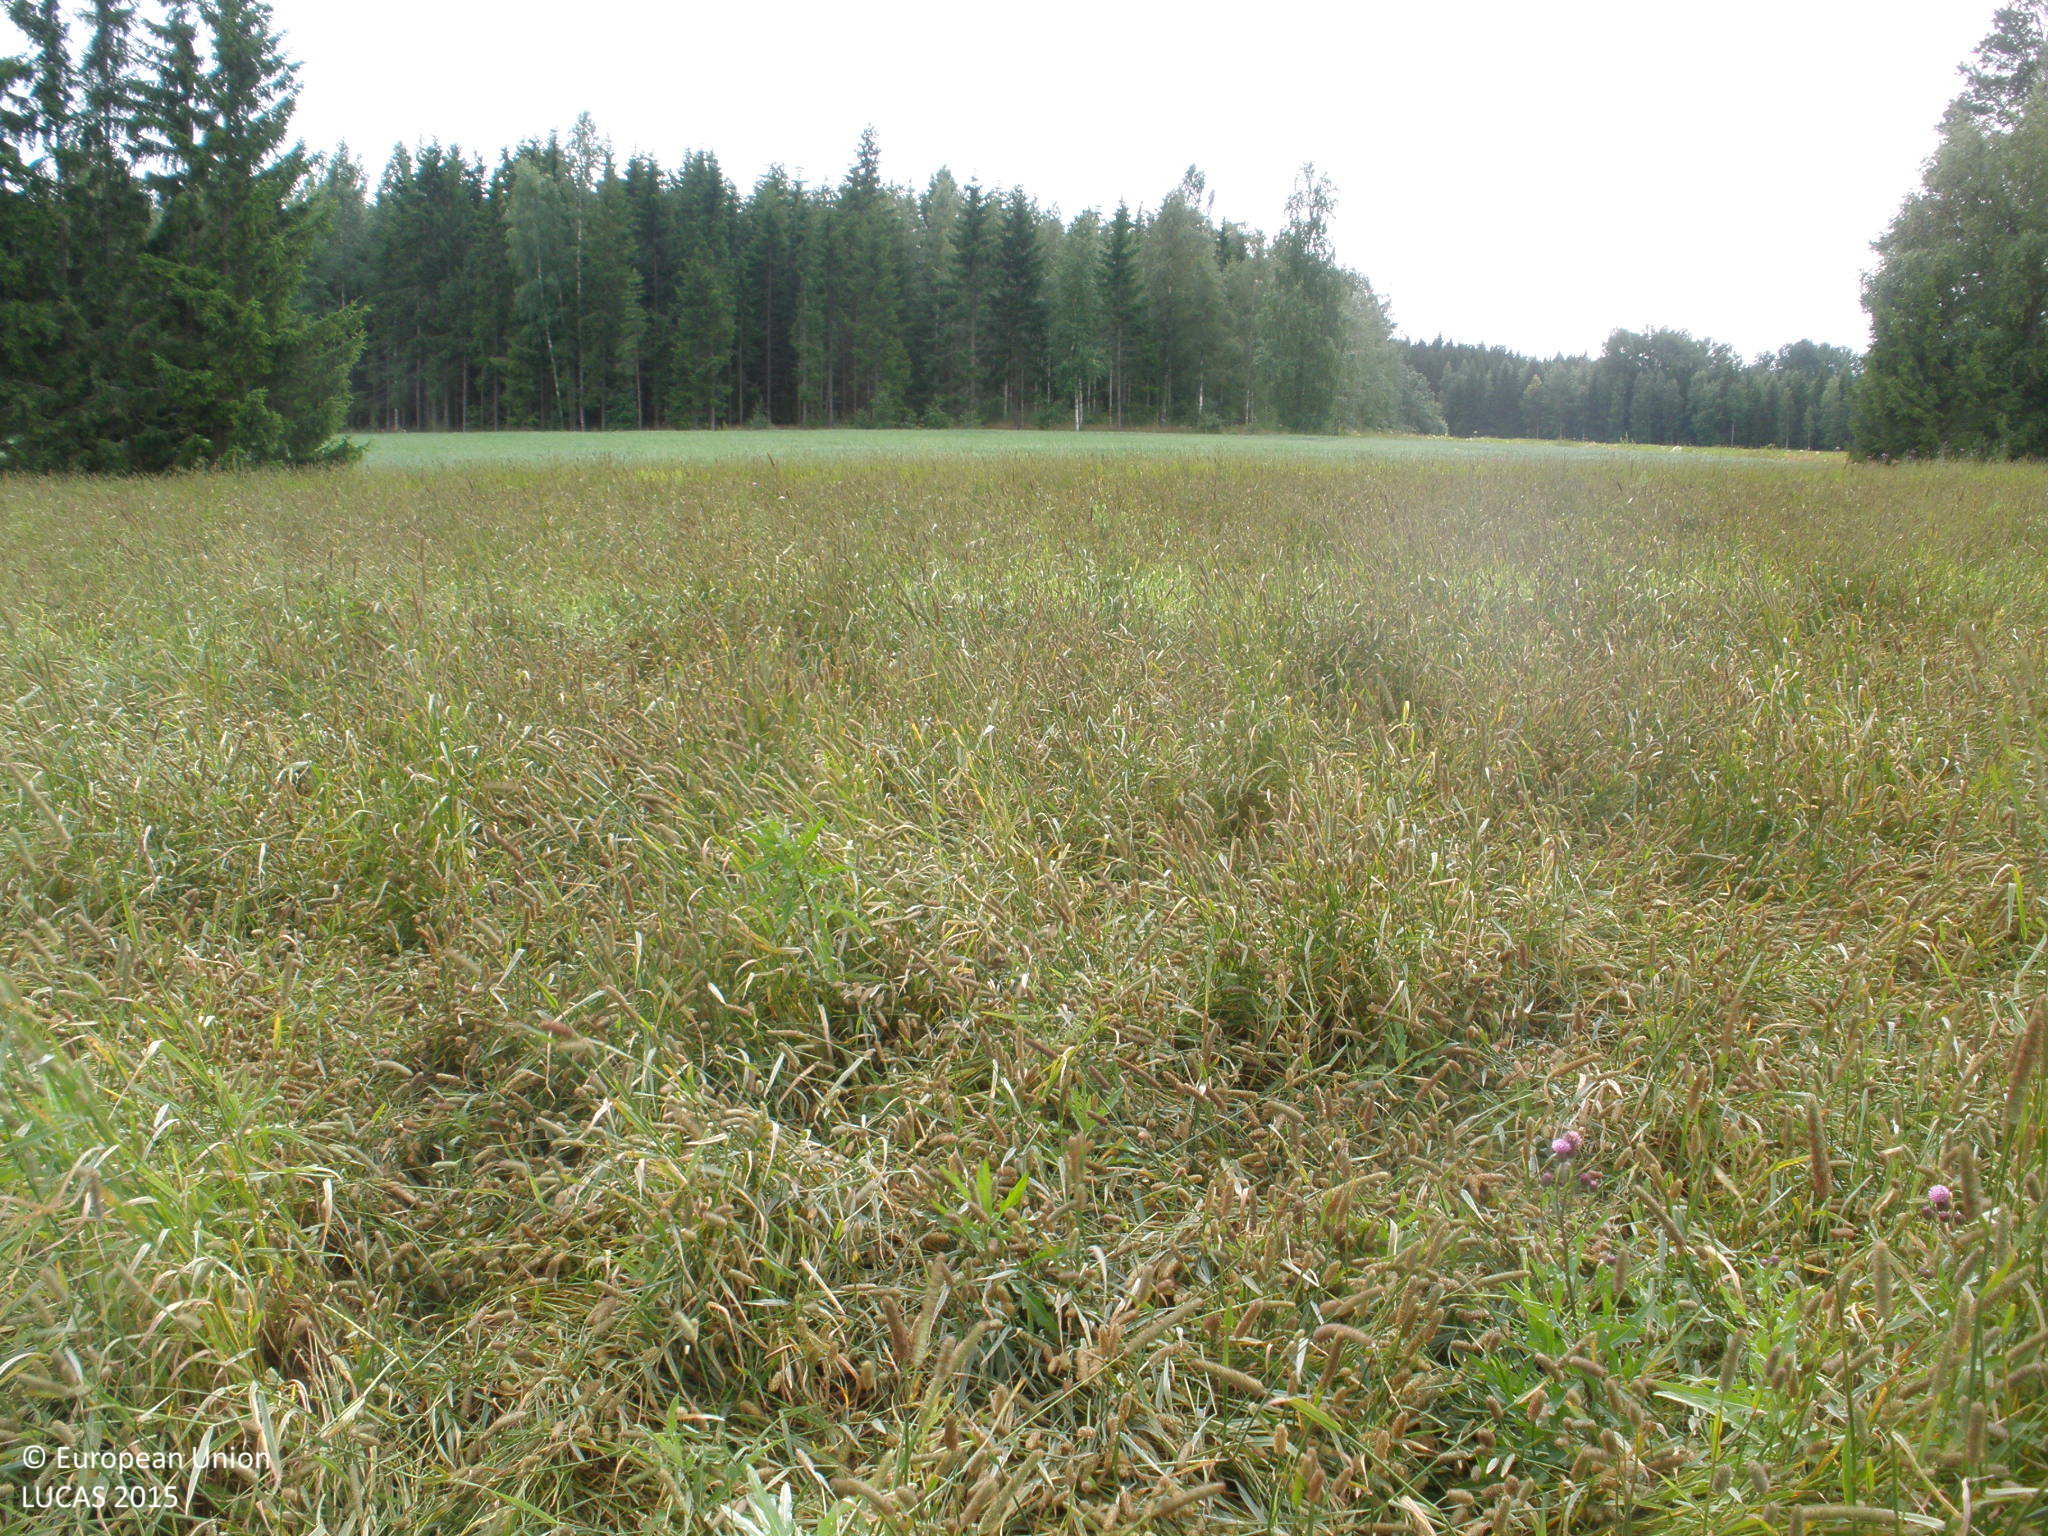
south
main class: Cropland
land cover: Temporary grasslands
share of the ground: > 75 %
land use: Agriculture (excluding fallow land and kitchen gardens)
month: July
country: FI
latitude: 60.6454
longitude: 23.4902
